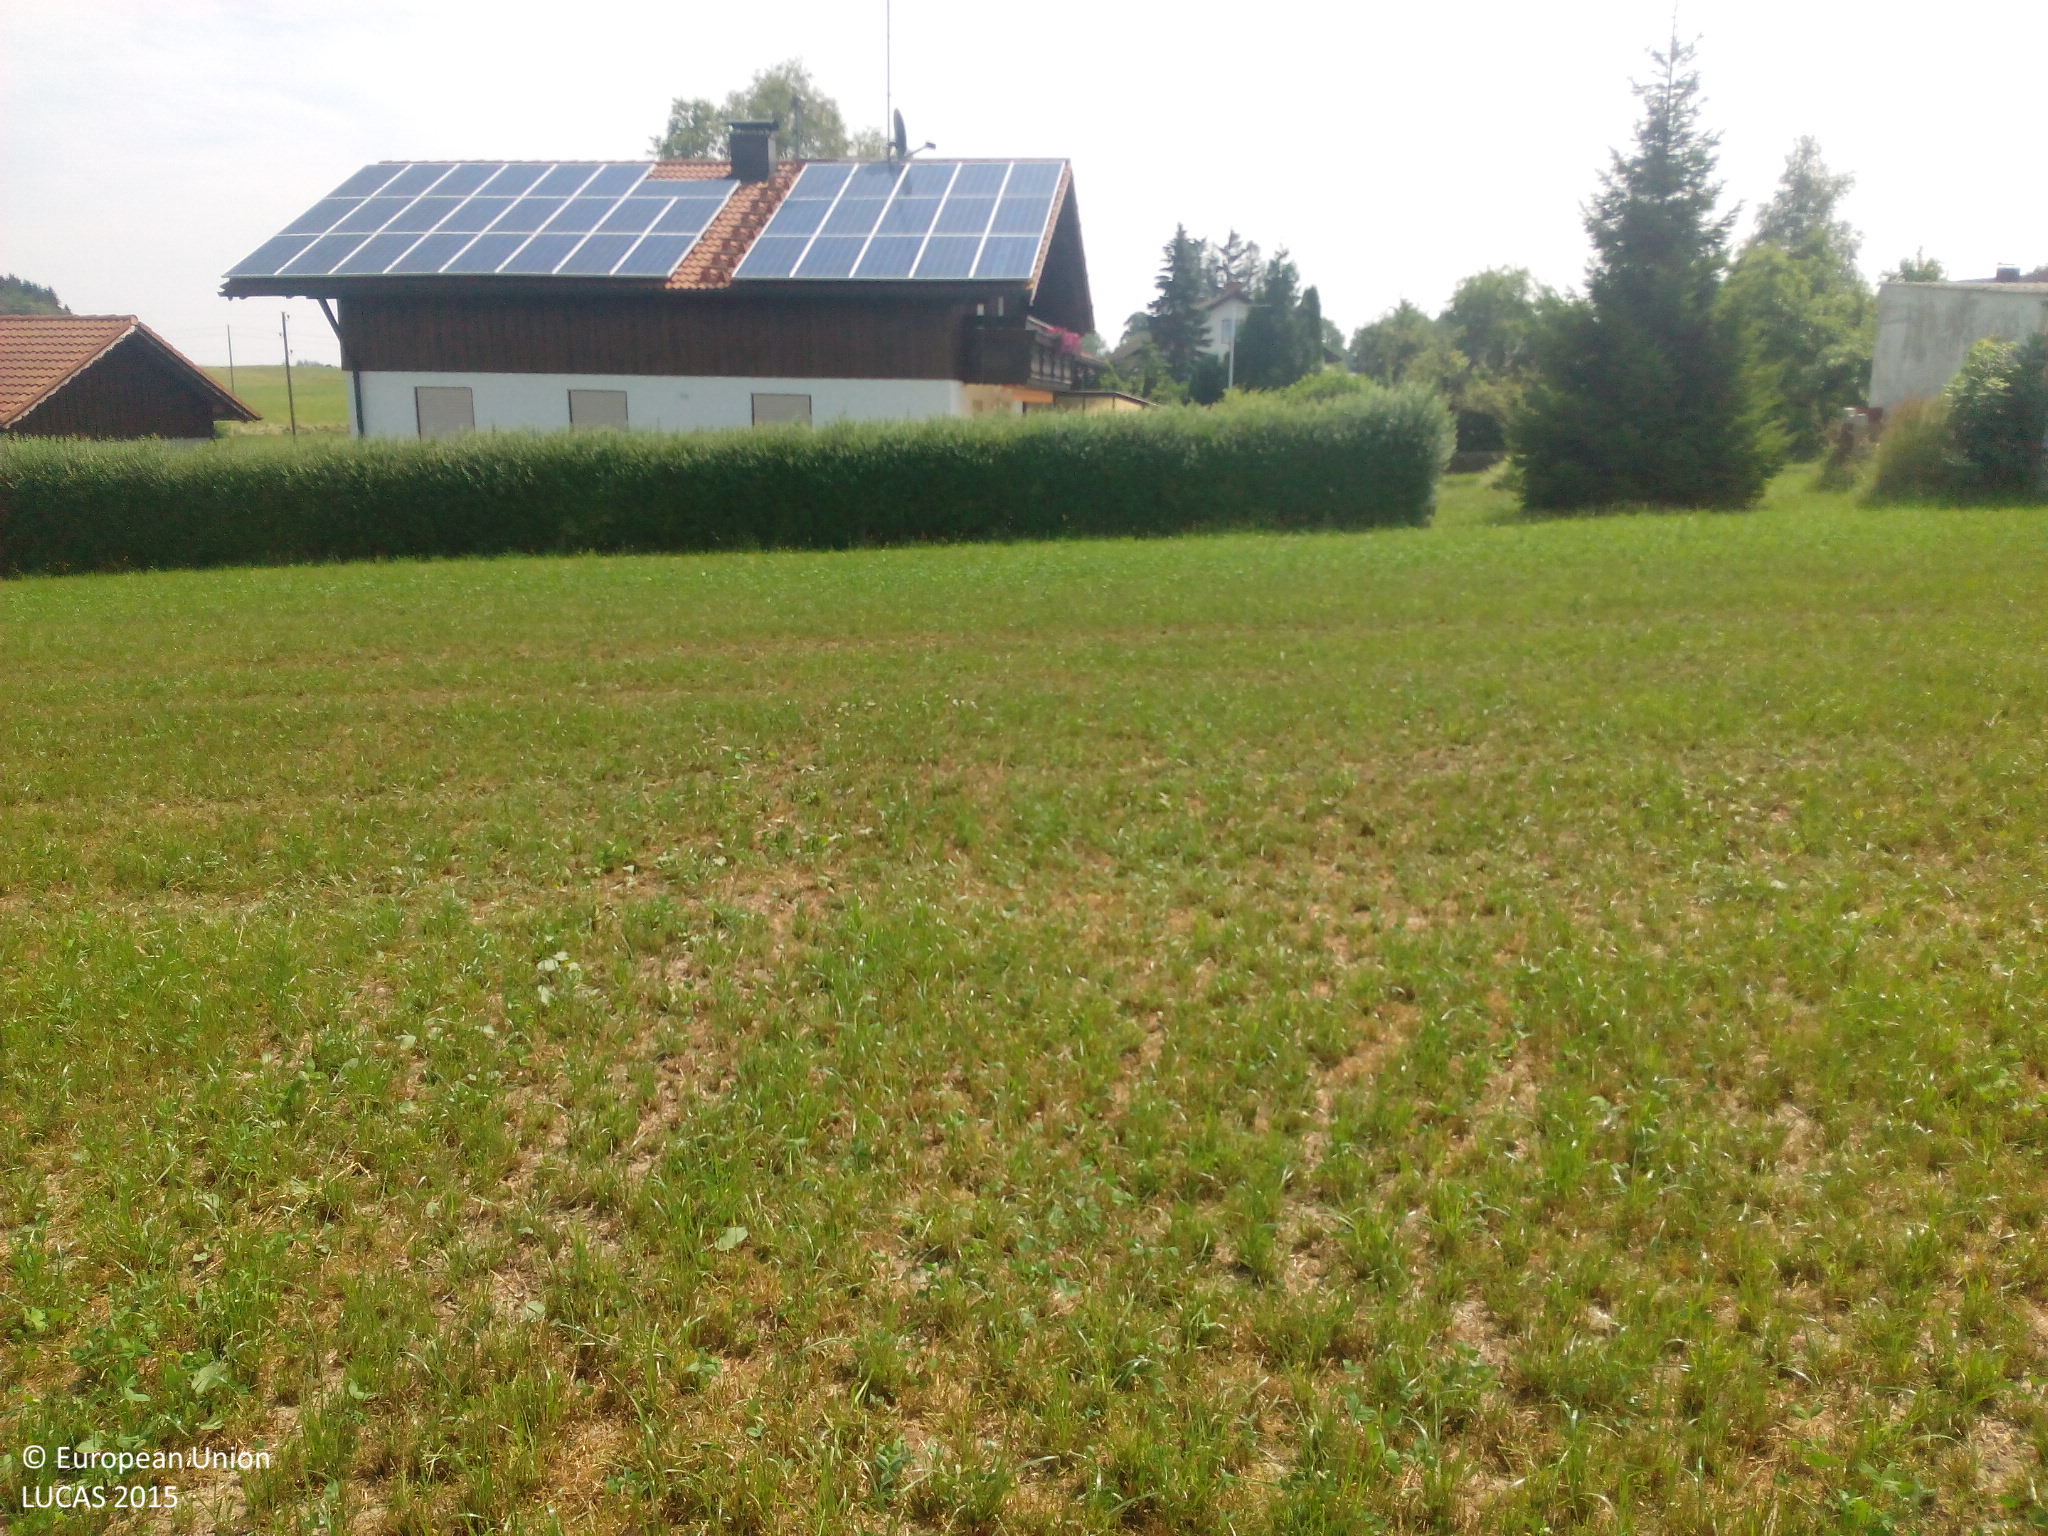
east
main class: Cropland
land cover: Temporary grasslands
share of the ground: 50 - 75 %
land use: Agriculture (excluding fallow land and kitchen gardens)
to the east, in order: Temporary grasslands; Grass margins; Artificial constructions in urban areas; Grassland without tree/shrub cover; Electric lines; Grassland without tree/shrub cover; Electric lines; Grassland without tree/shrub cover
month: July
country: DE
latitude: 47.8595
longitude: 10.9483
